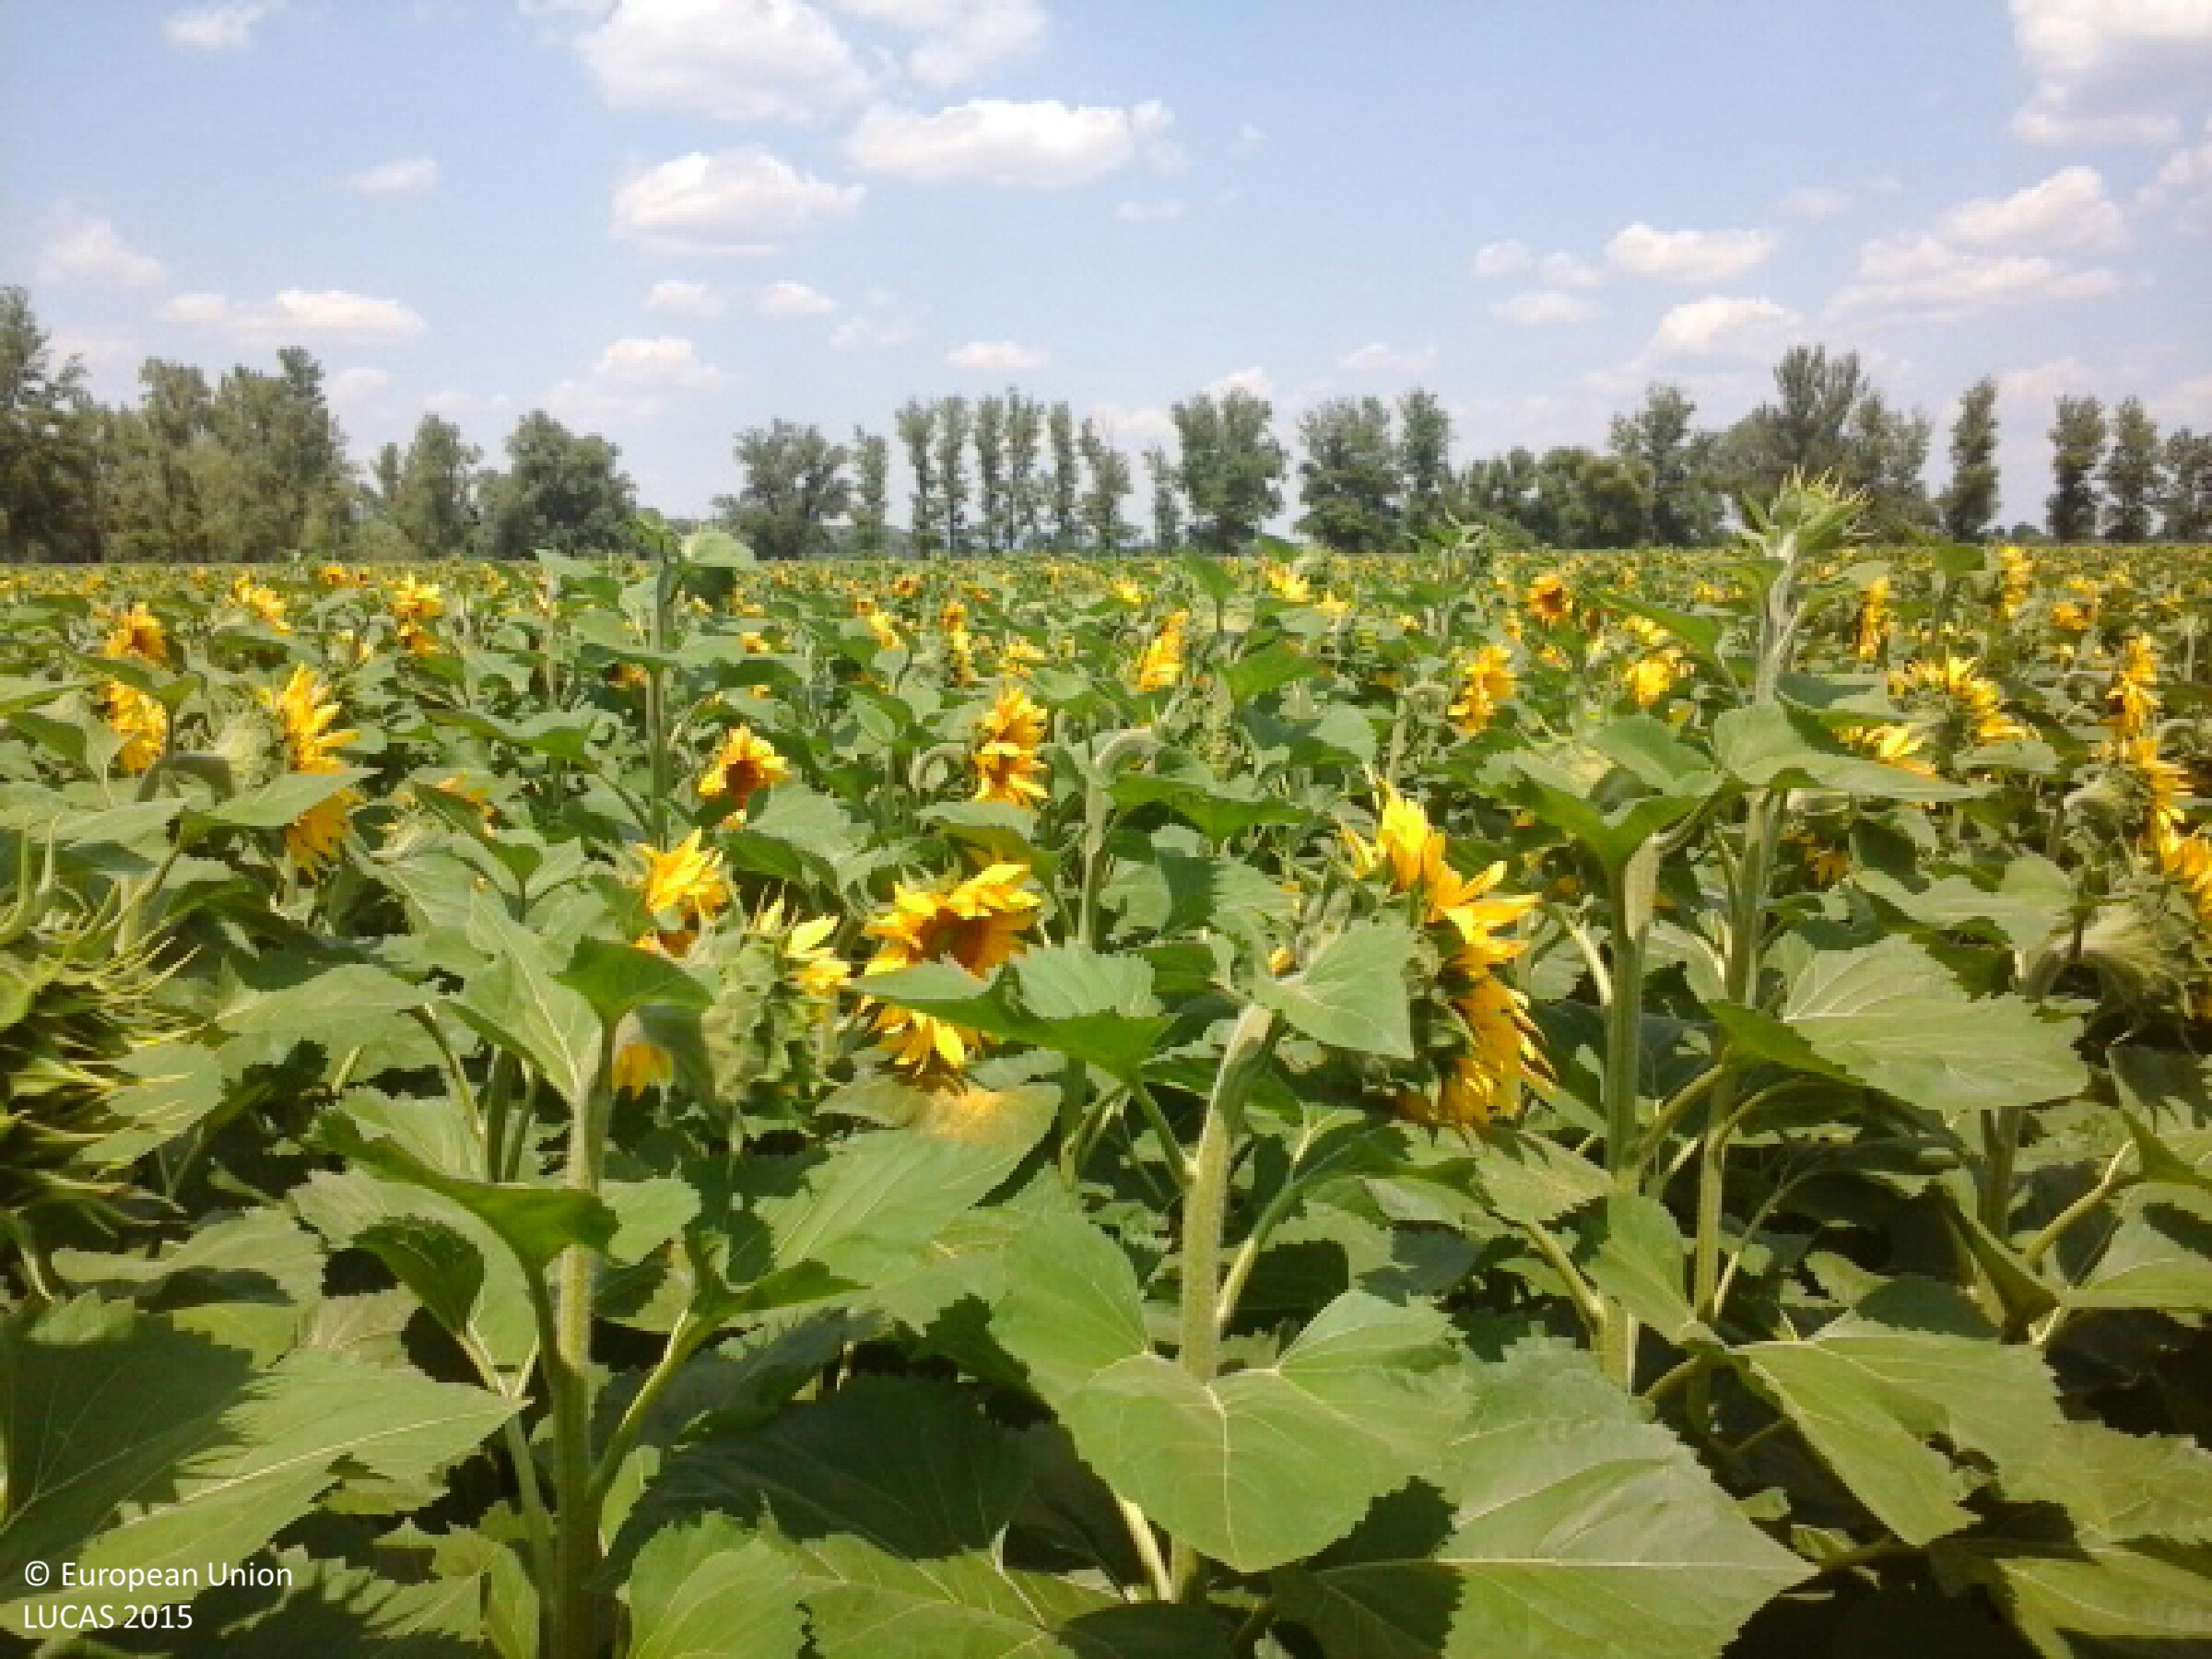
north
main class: Cropland
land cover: Sunflower
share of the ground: > 75 %
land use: Agriculture (excluding fallow land and kitchen gardens)
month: July
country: HU
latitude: 48.2995
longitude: 21.6006
